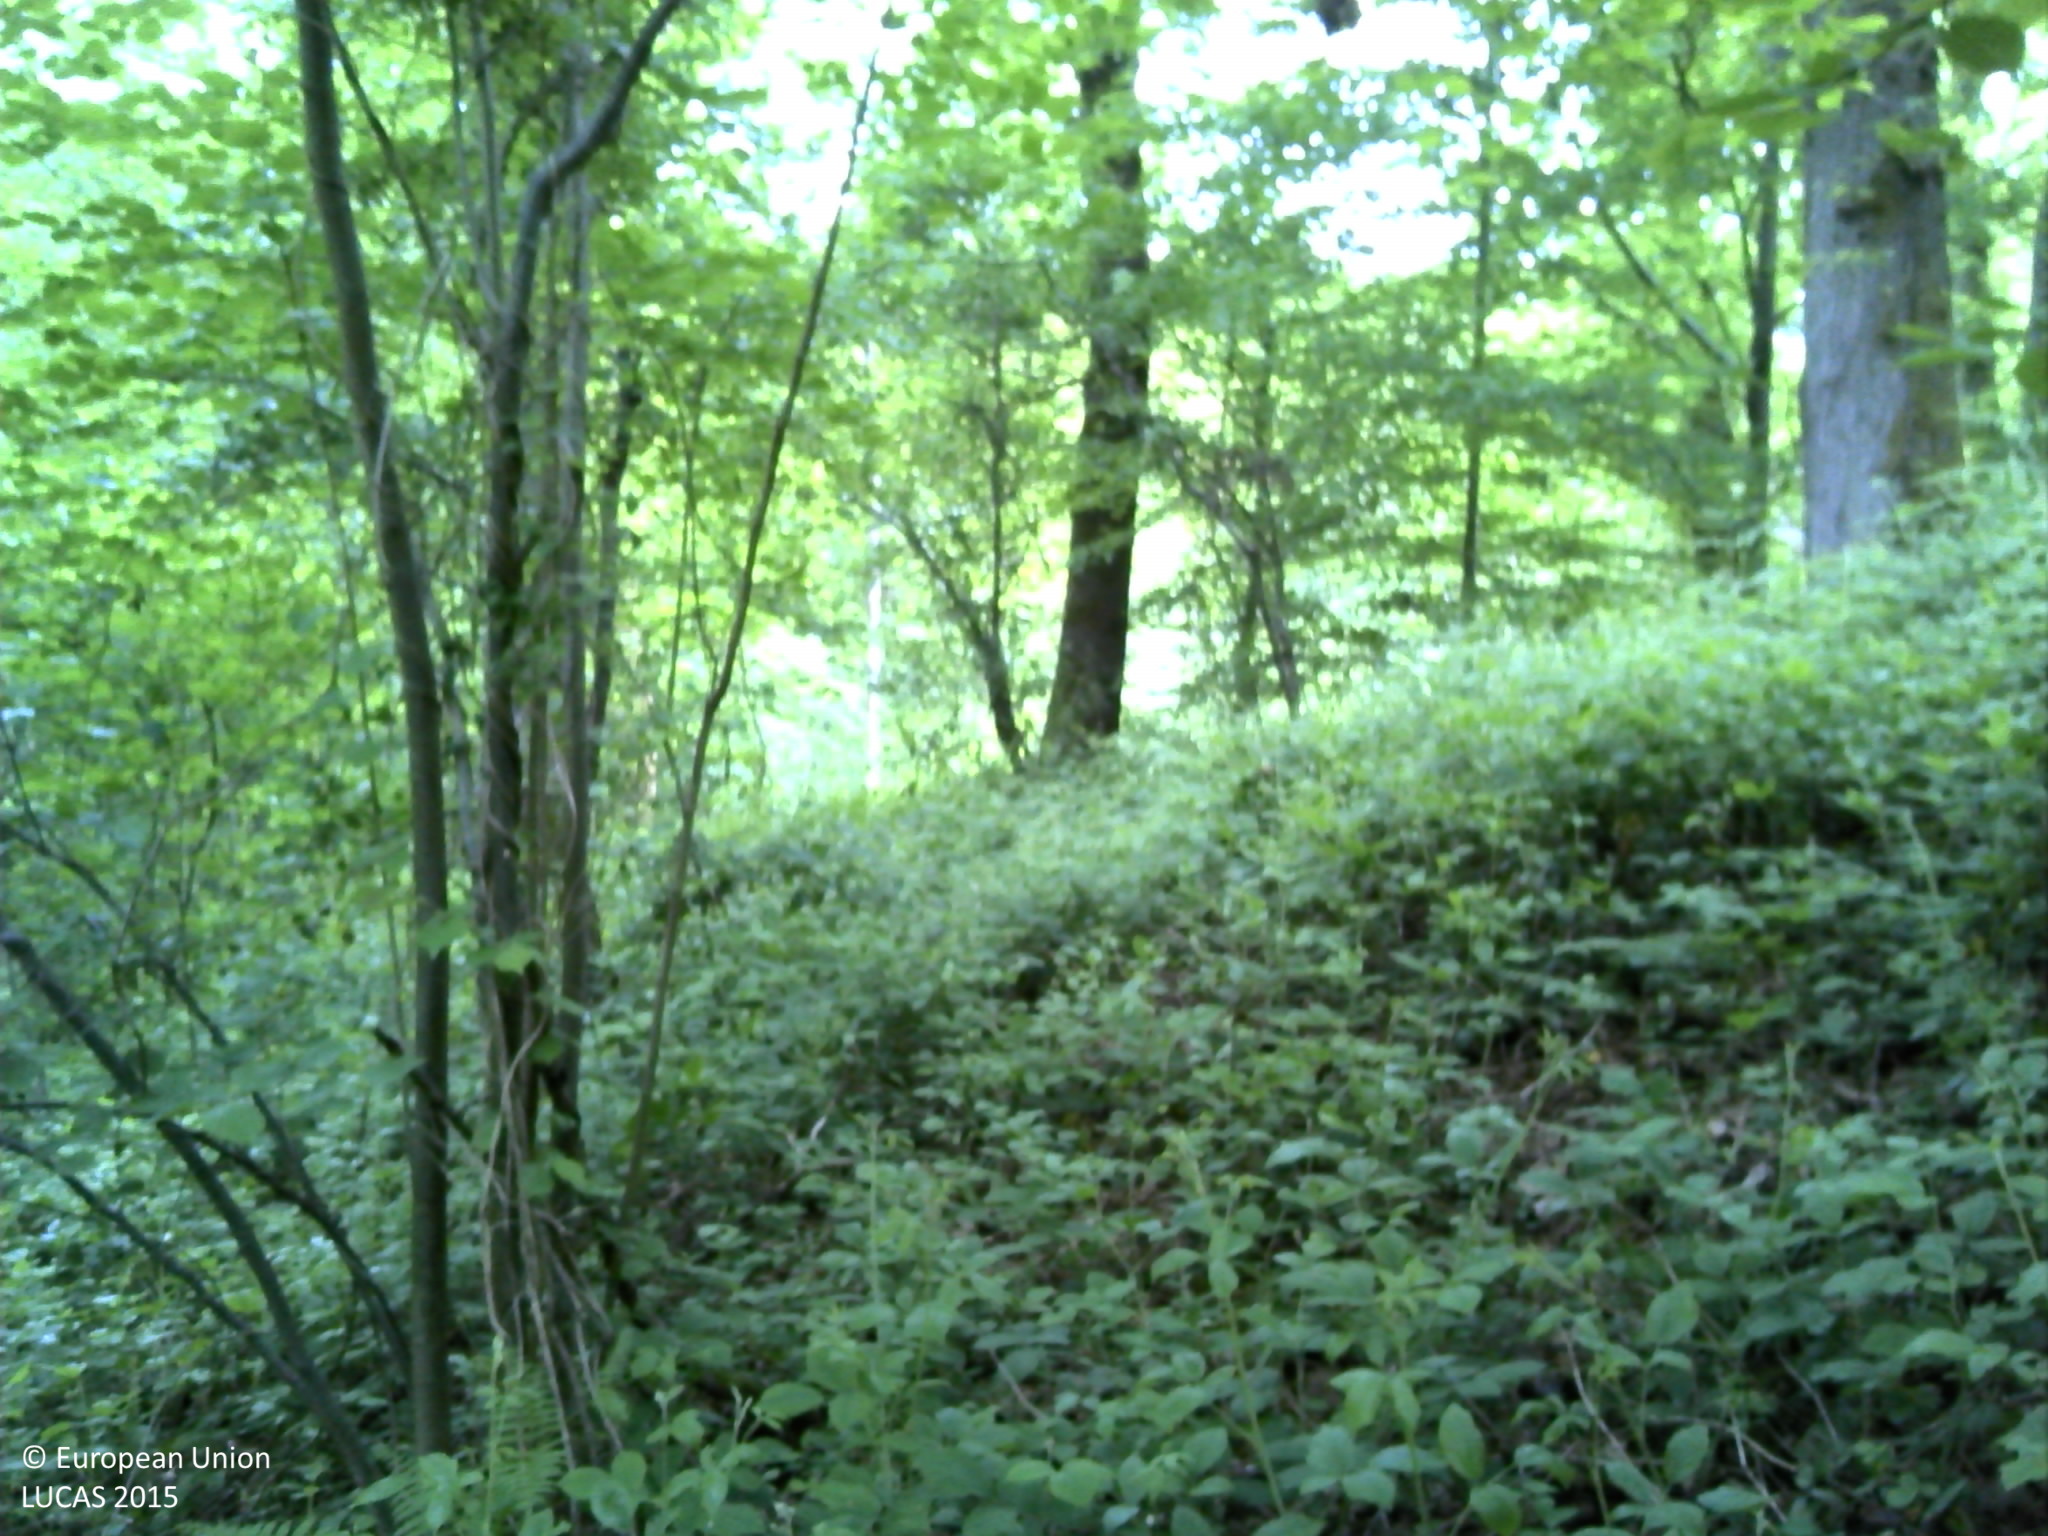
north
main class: Woodland
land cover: Broadleaved woodland
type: acidophilous oak and oak-birch forest
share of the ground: > 75 %
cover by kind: broadleaved forest trees 85 %, herbaceous plants 15 %
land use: Forestry
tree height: > 5 m
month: June
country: FR
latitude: 49.5746
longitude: 1.0025
